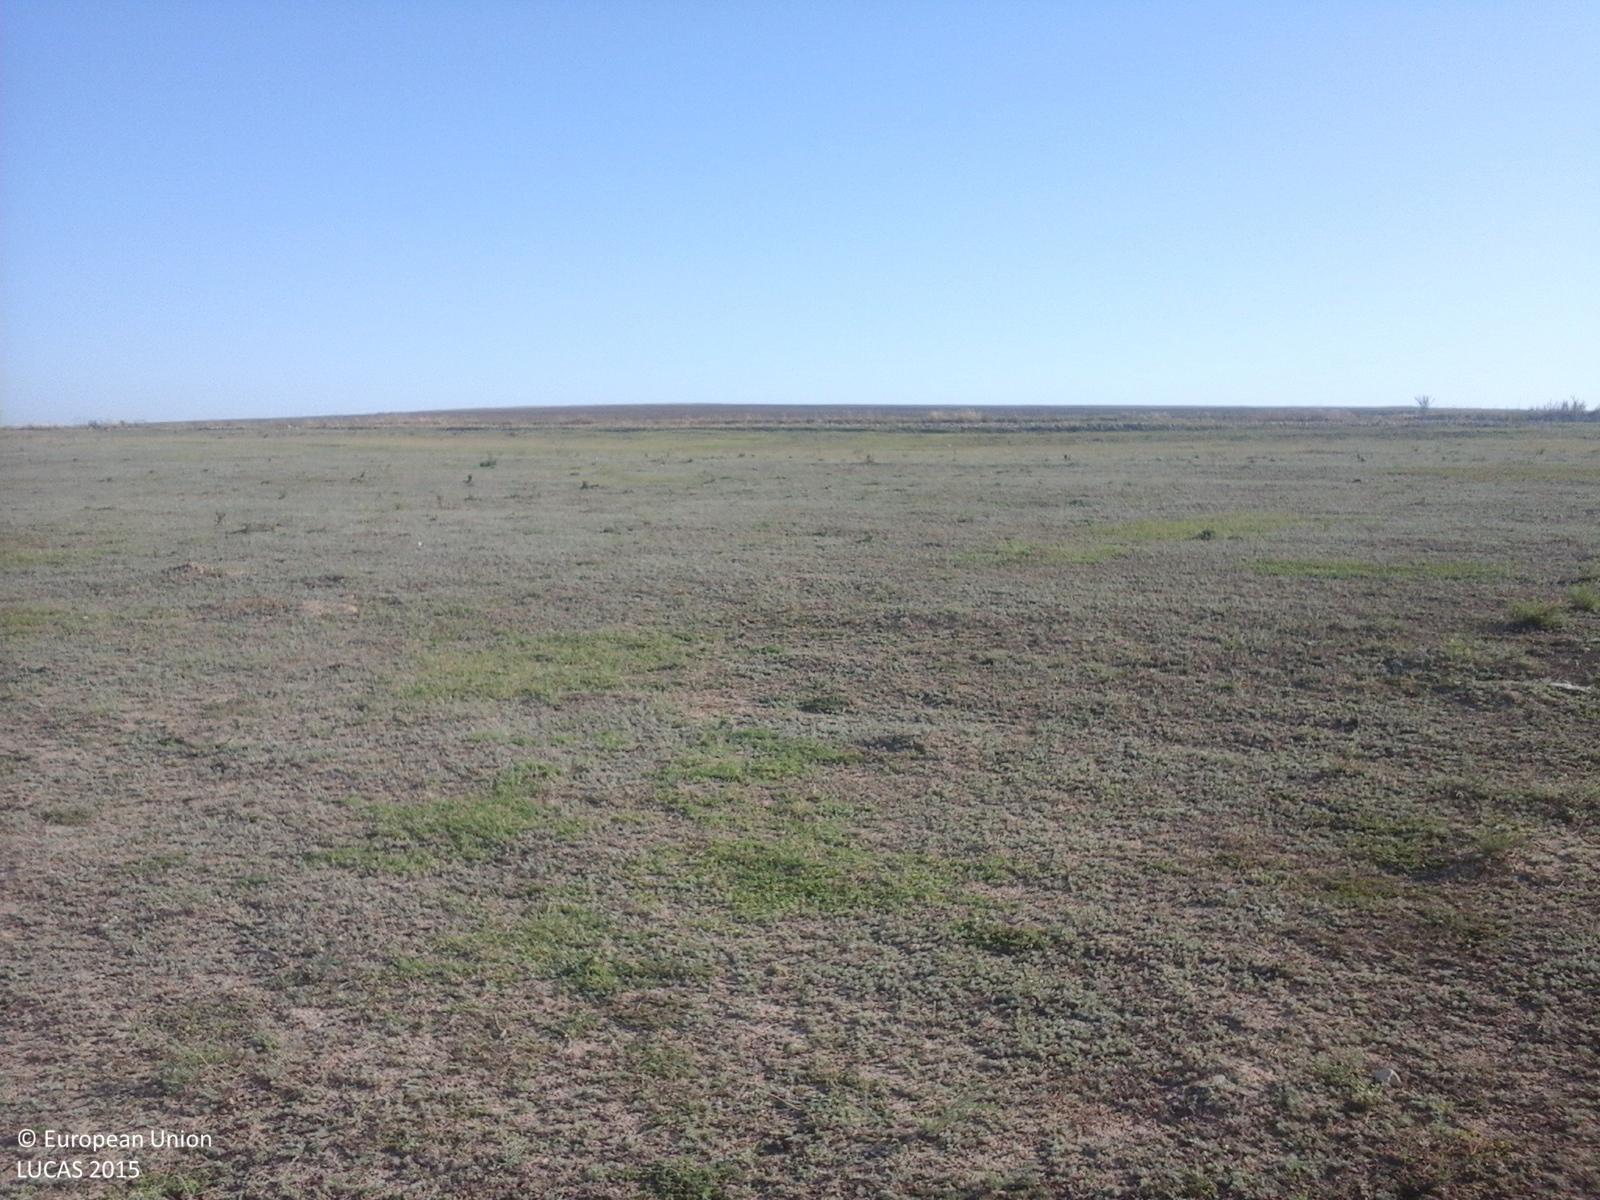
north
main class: Grassland
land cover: Grassland without tree/shrub cover
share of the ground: > 75 %
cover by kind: herbaceous plants 90 %, unconsolidated bare surface 10 %
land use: Agriculture (excluding fallow land and kitchen gardens)
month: August
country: RO
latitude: 44.4149
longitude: 28.5477
